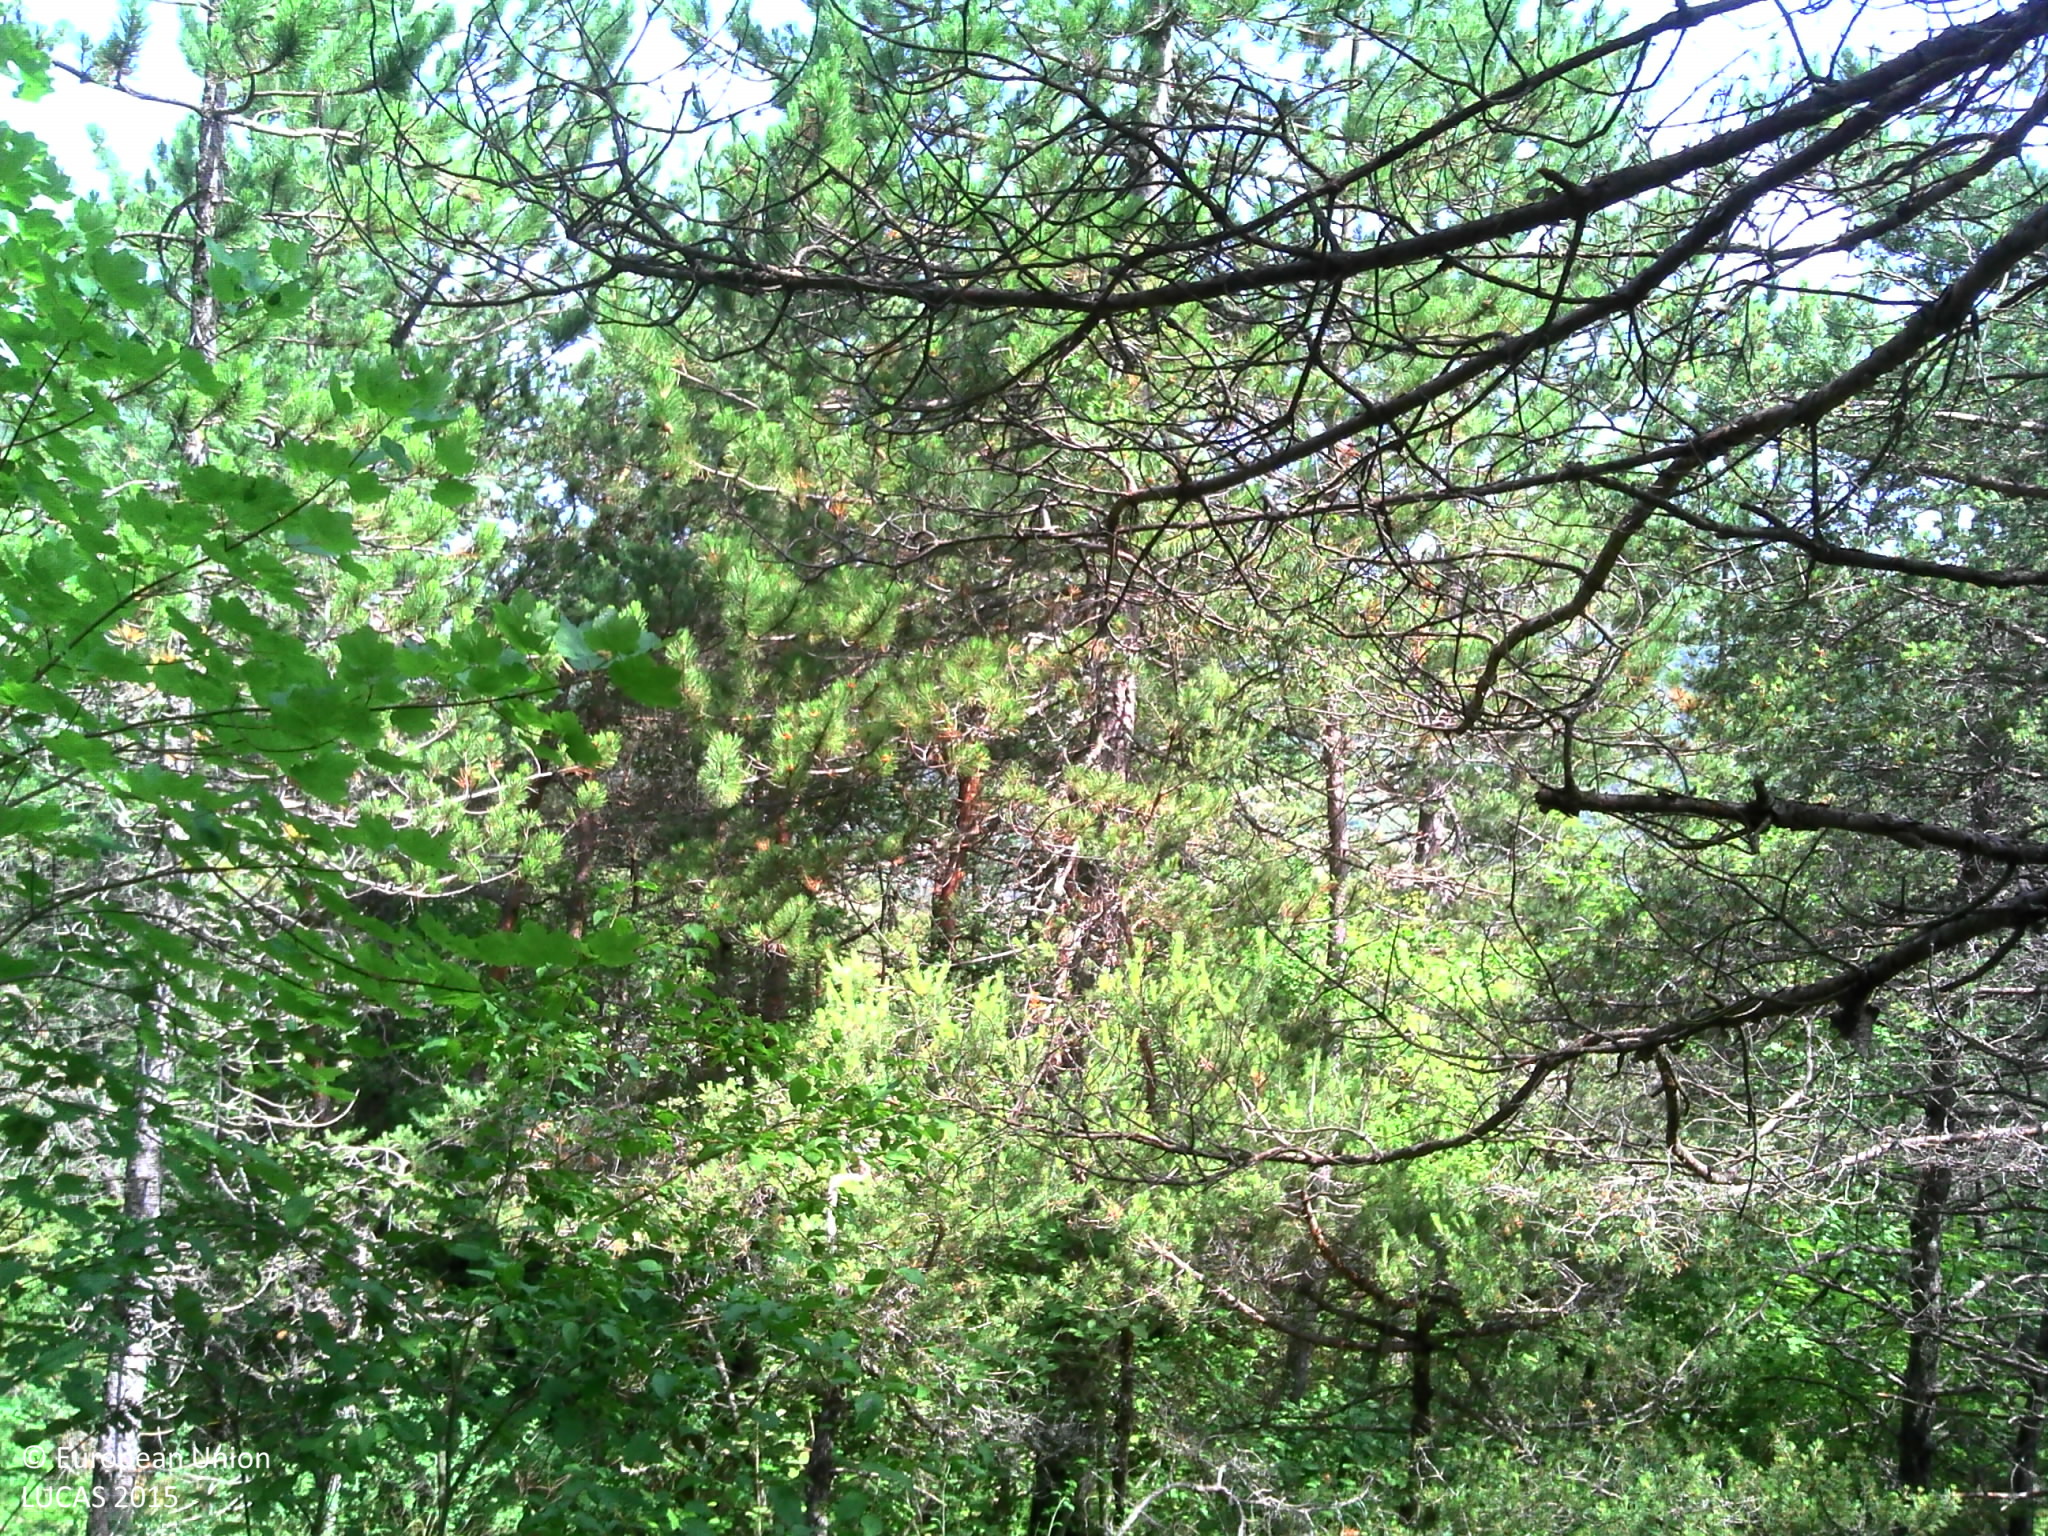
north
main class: Woodland
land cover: Pine dominated mixed woodland
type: coniferous forest of the mediterranean region
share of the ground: > 75 %
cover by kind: coniferous forest trees 70 %, broadleaved forest trees 25 %, herbaceous plants 5 %
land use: Forestry
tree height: > 5 m
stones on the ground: 10 - 25 %
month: June
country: FR
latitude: 44.6742
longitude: 5.2256
